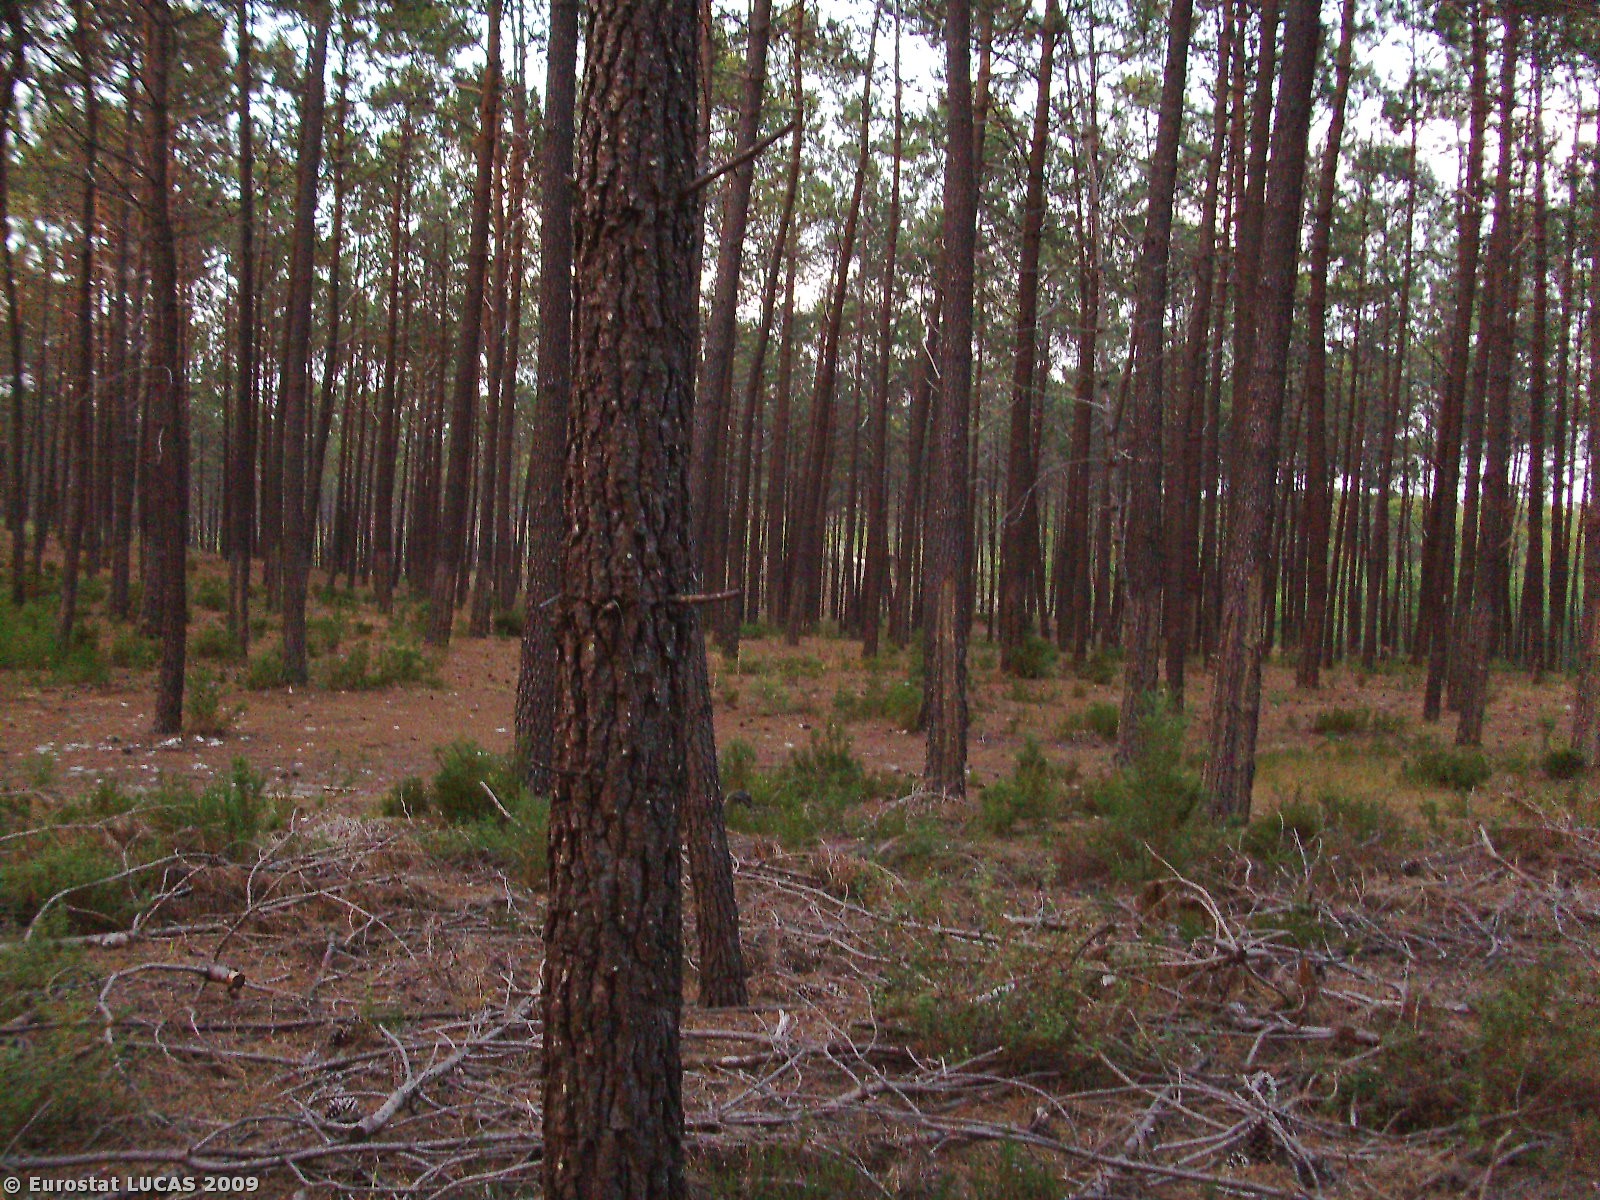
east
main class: Woodland
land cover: Coniferous woodland
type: coniferous forest of the mediterranean region
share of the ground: > 75 %
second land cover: Shrubland with sparse tree cover
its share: 10 - 25 %
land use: Forestry
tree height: > 5 m
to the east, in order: Coniferous woodland; Shrubland with sparse tree cover; Coniferous woodland; Tracks; Coniferous woodland; Tracks; Coniferous woodland; Ditches and canals; Coniferous woodland
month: July
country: PT
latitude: 39.6281
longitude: -9.0217
